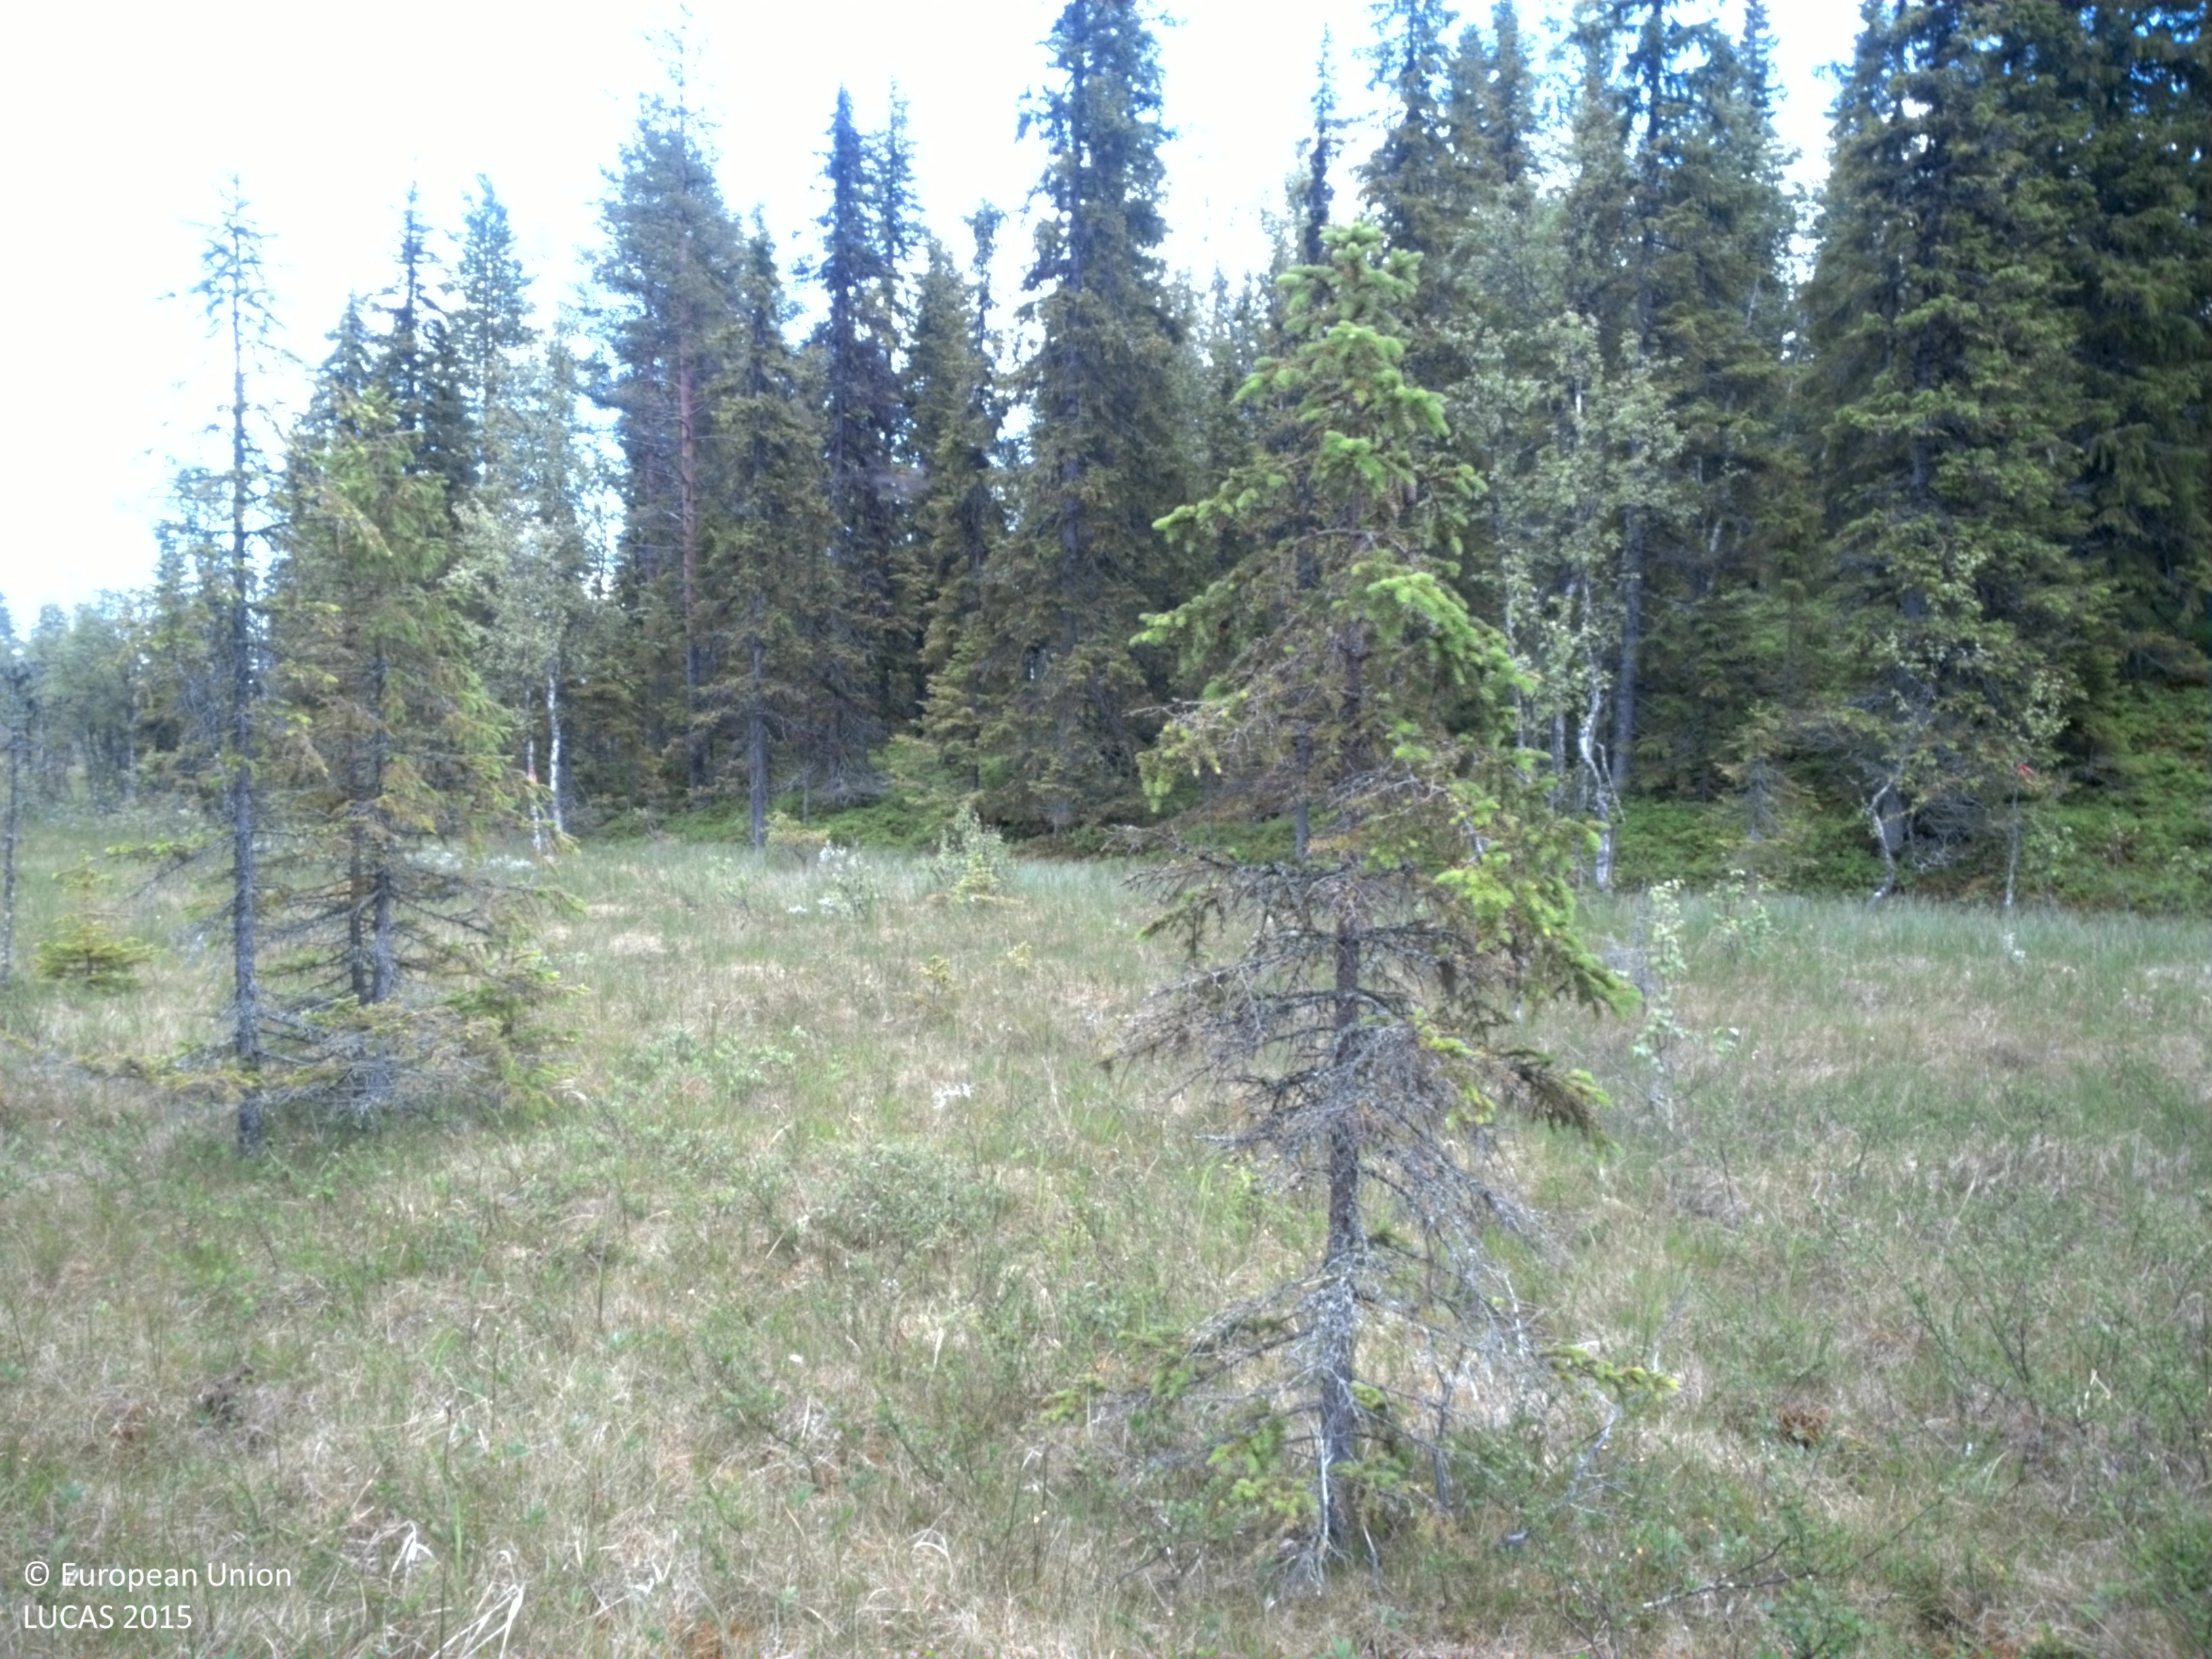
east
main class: Woodland
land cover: Spruce dominated coniferous woodland
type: mire and swamp forests
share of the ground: 10 - 25 %
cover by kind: coniferous forest trees 50 %, shrubs 25 %, herbaceous plants 25 %
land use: Forestry
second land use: Amenities, museums, leisure
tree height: < 5 m
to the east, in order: Spruce dominated coniferous woodland; Spruce dominated mixed woodland; Spruce dominated coniferous woodland; Spruce dominated mixed woodland; Peatbogs; Spruce dominated coniferous woodland; Peatbogs; Ponds and wetlands; Peatbogs; Spruce dominated mixed woodland
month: July
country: SE
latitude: 64.4754
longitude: 18.2255
